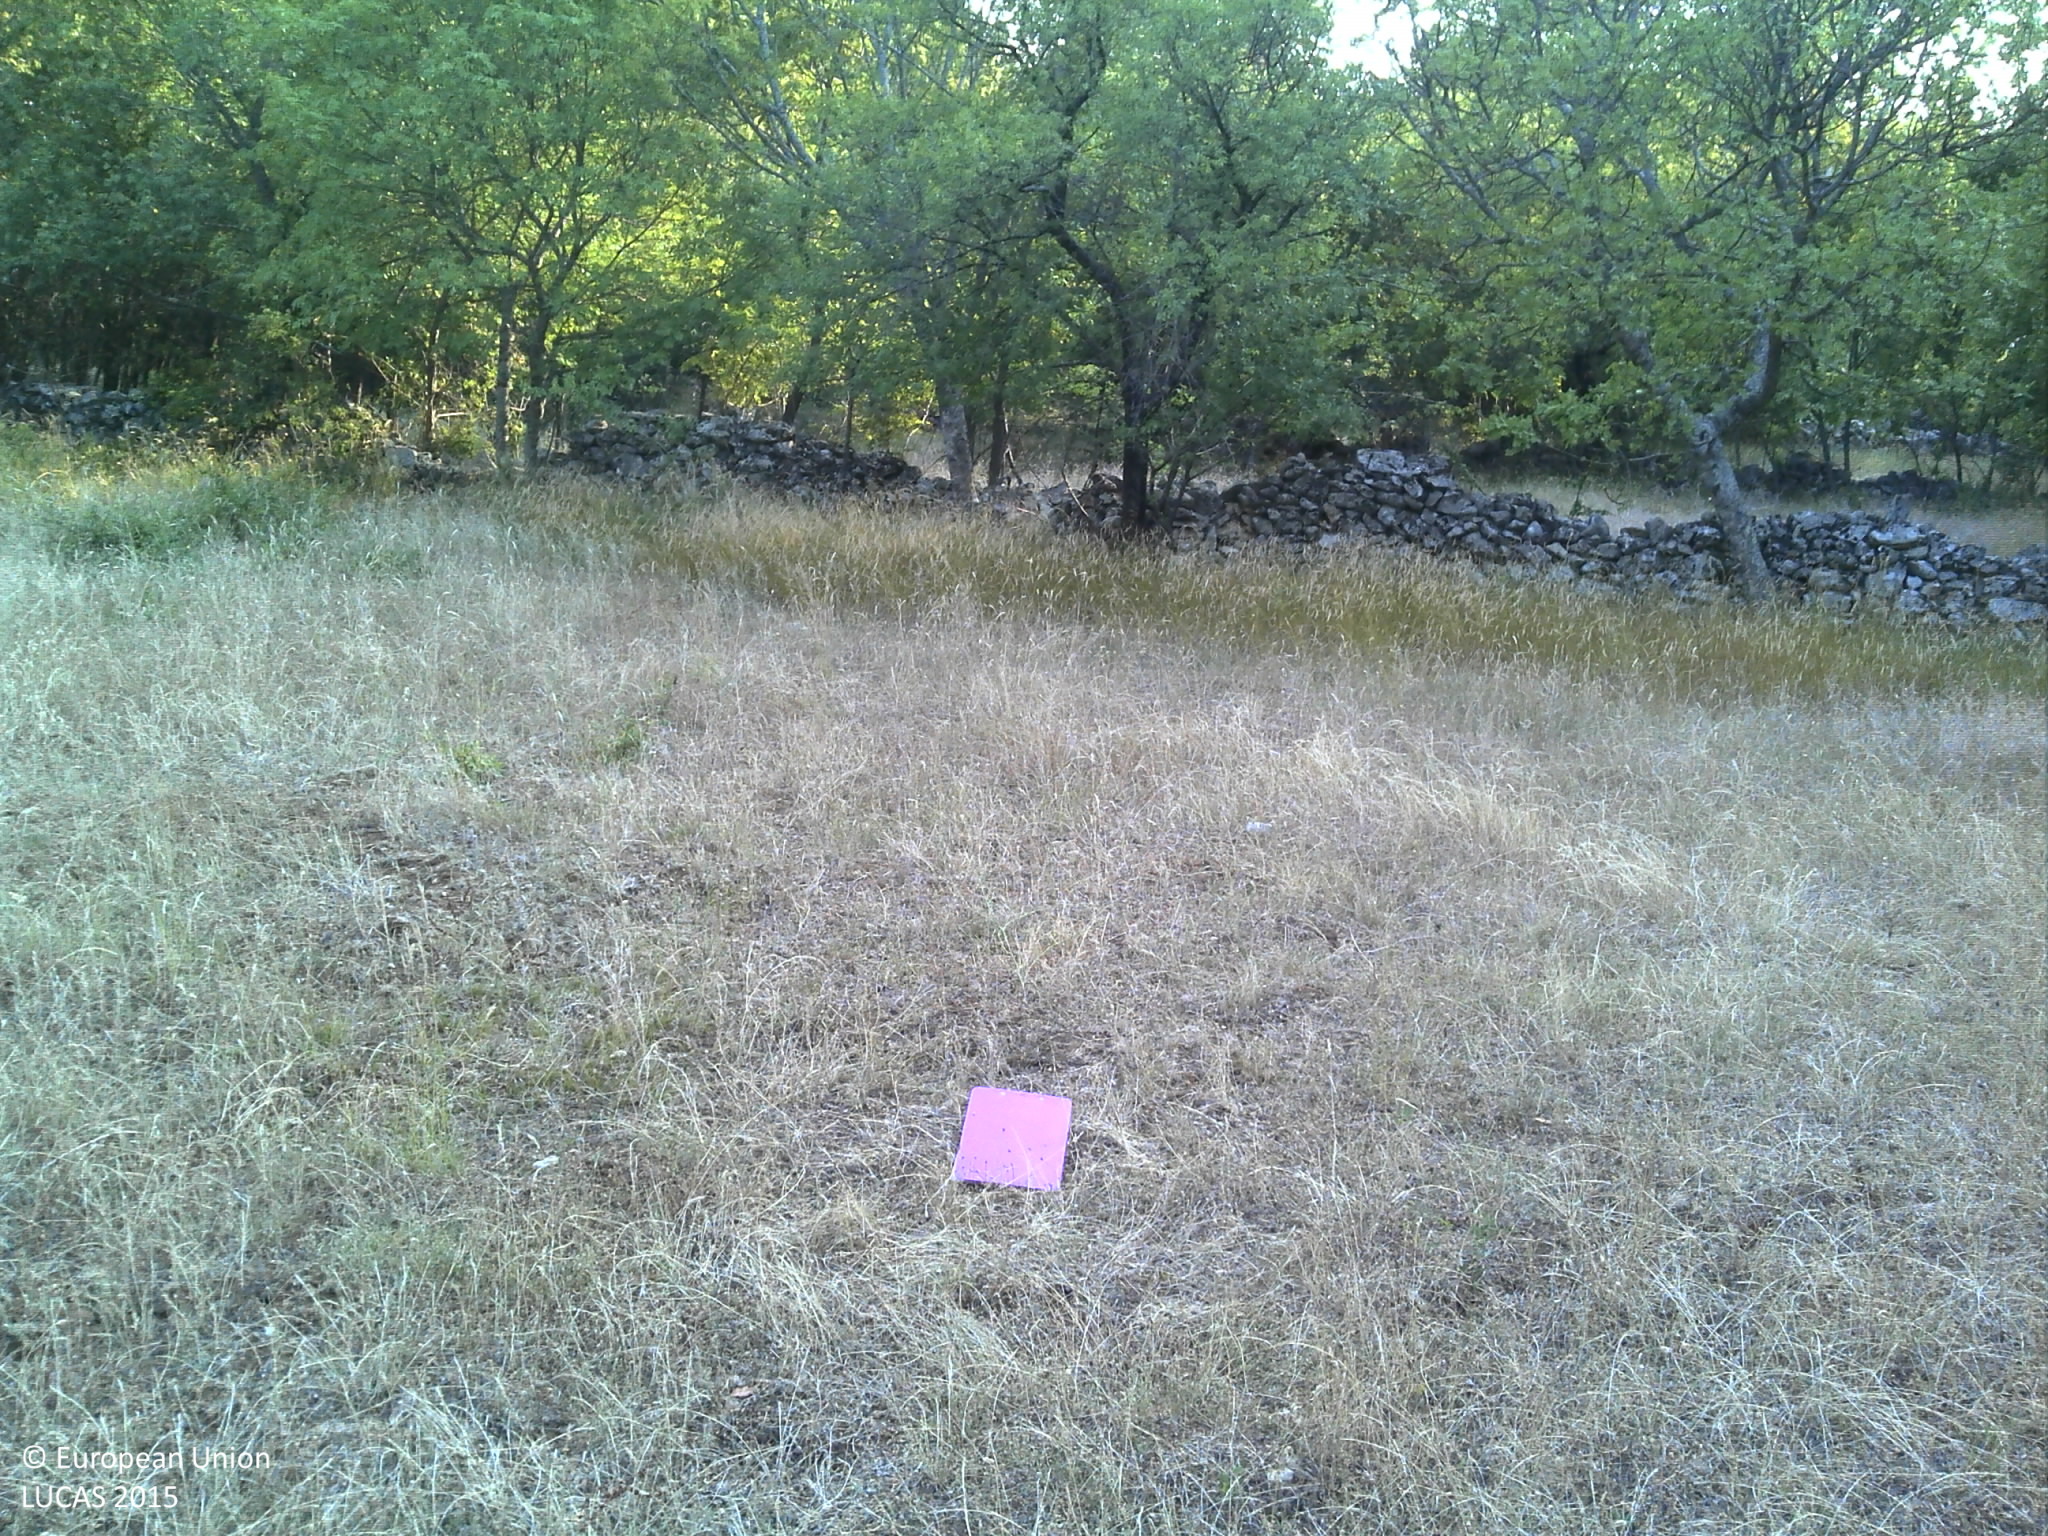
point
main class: Grassland
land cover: Grassland without tree/shrub cover
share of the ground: > 75 %
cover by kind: herbaceous plants 95 %, shrubs 5 %
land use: Semi-natural and natural areas not in use
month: July
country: HR
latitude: 43.9445
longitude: 16.2593
